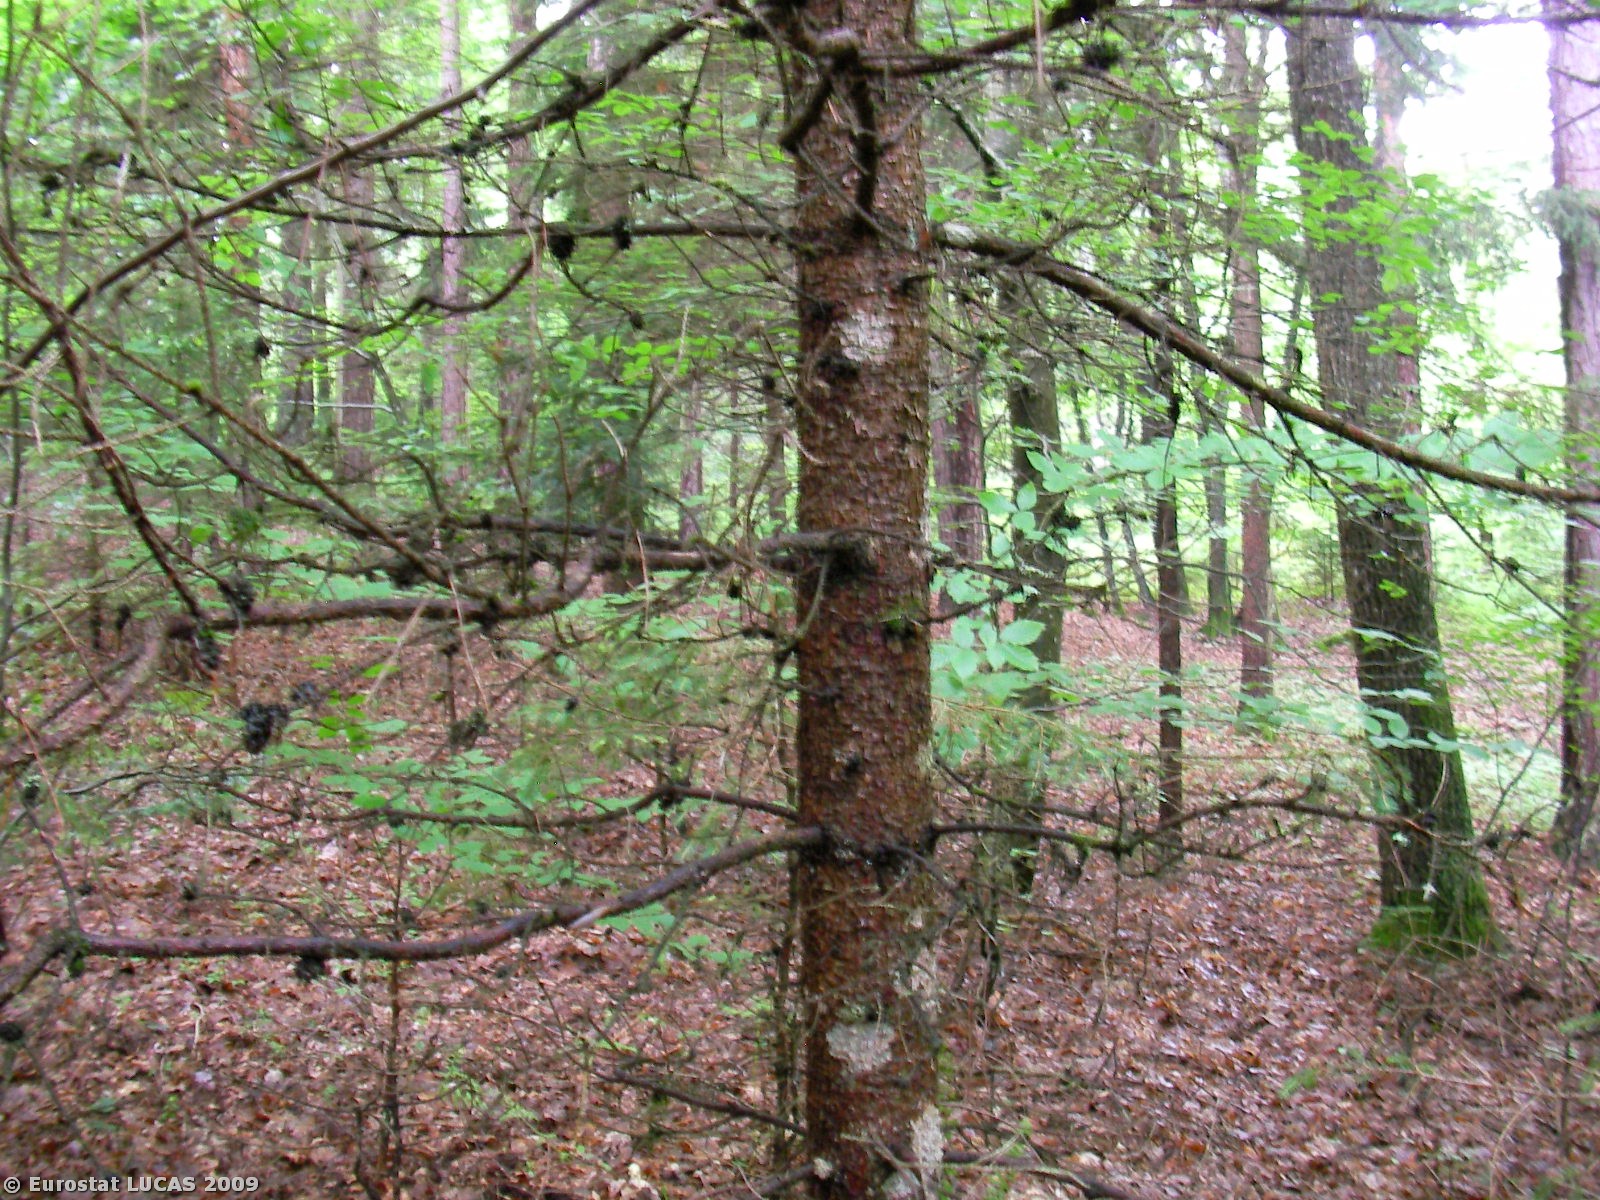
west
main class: Woodland
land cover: Coniferous woodland
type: hemiboreal forest and nemoral coniferous forest and mixed broadleaved-coniferous forest
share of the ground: > 75 %
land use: Forestry
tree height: > 5 m
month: June
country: AT
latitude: 47.1898
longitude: 15.7419
